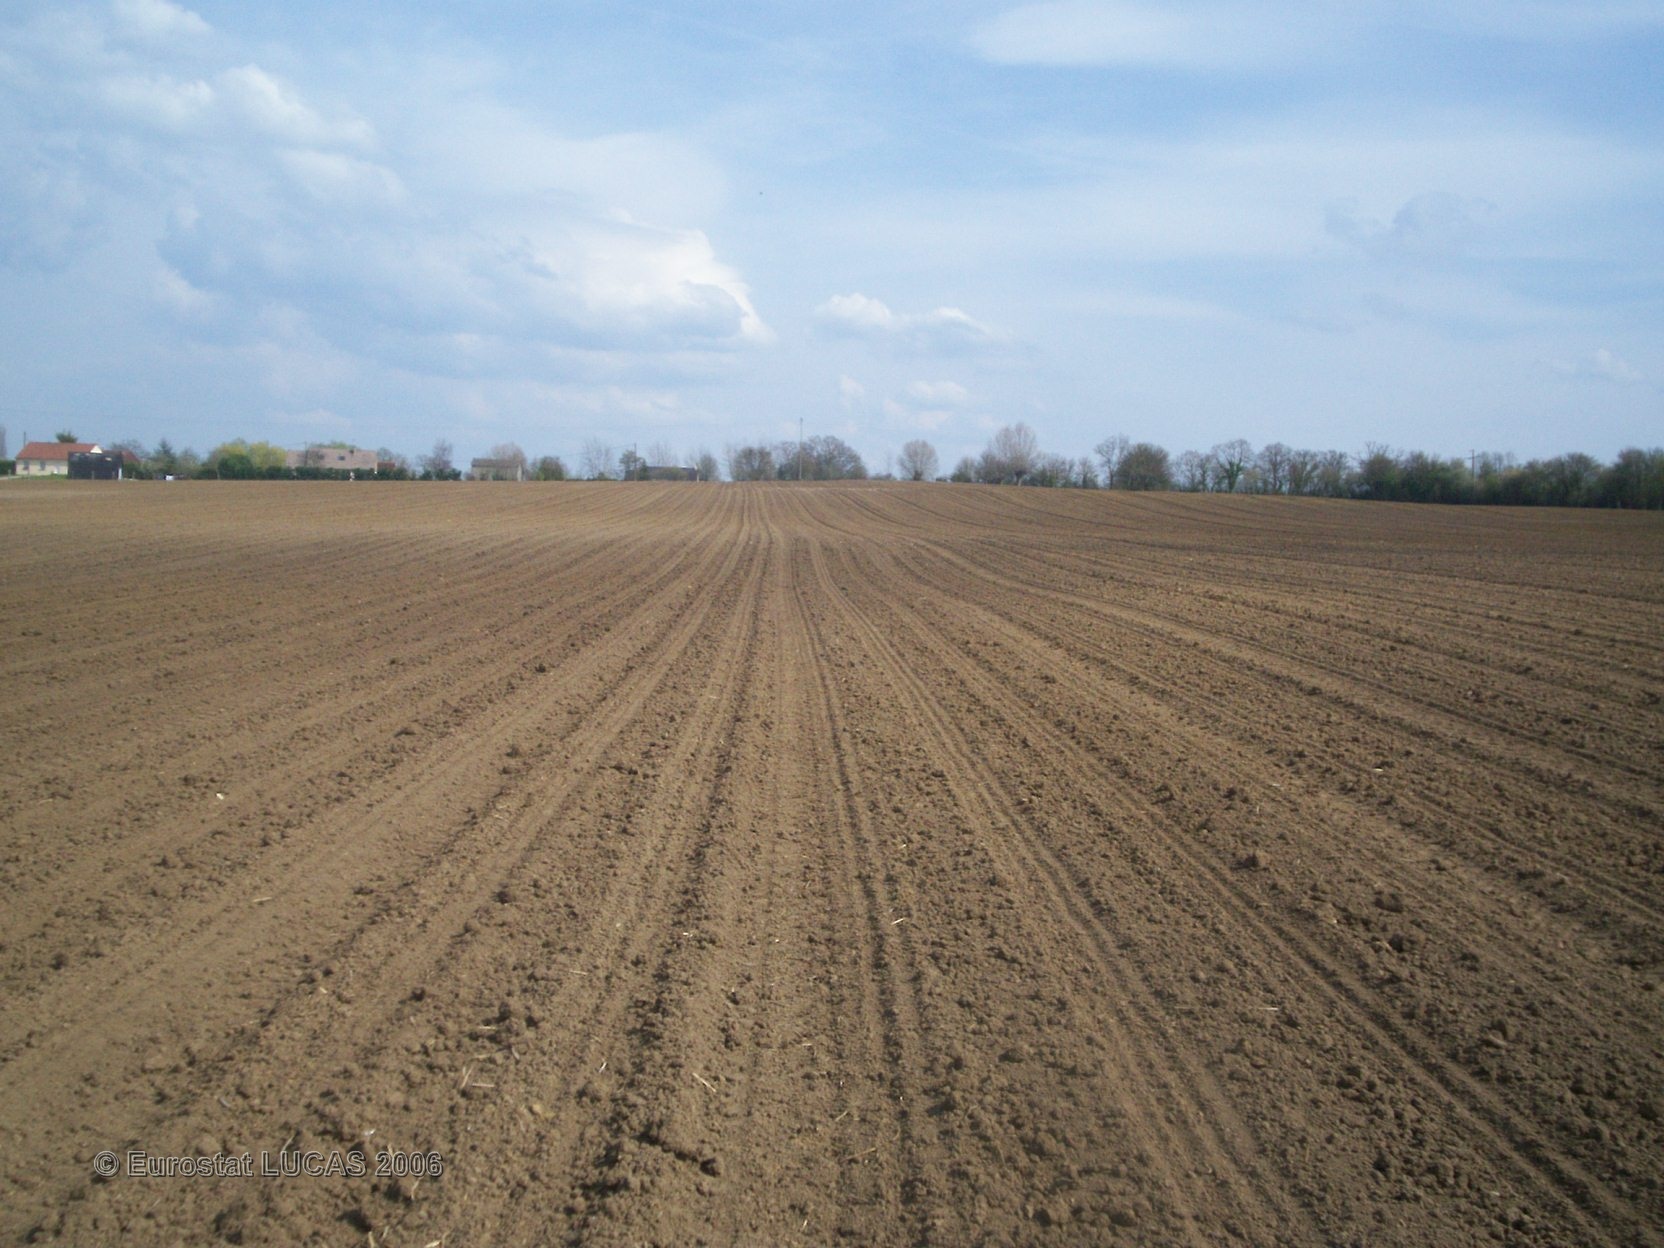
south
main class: Cropland
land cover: Maize
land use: Agriculture (excluding fallow land and kitchen gardens)
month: April
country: FR
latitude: 48.7743
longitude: 0.1055
